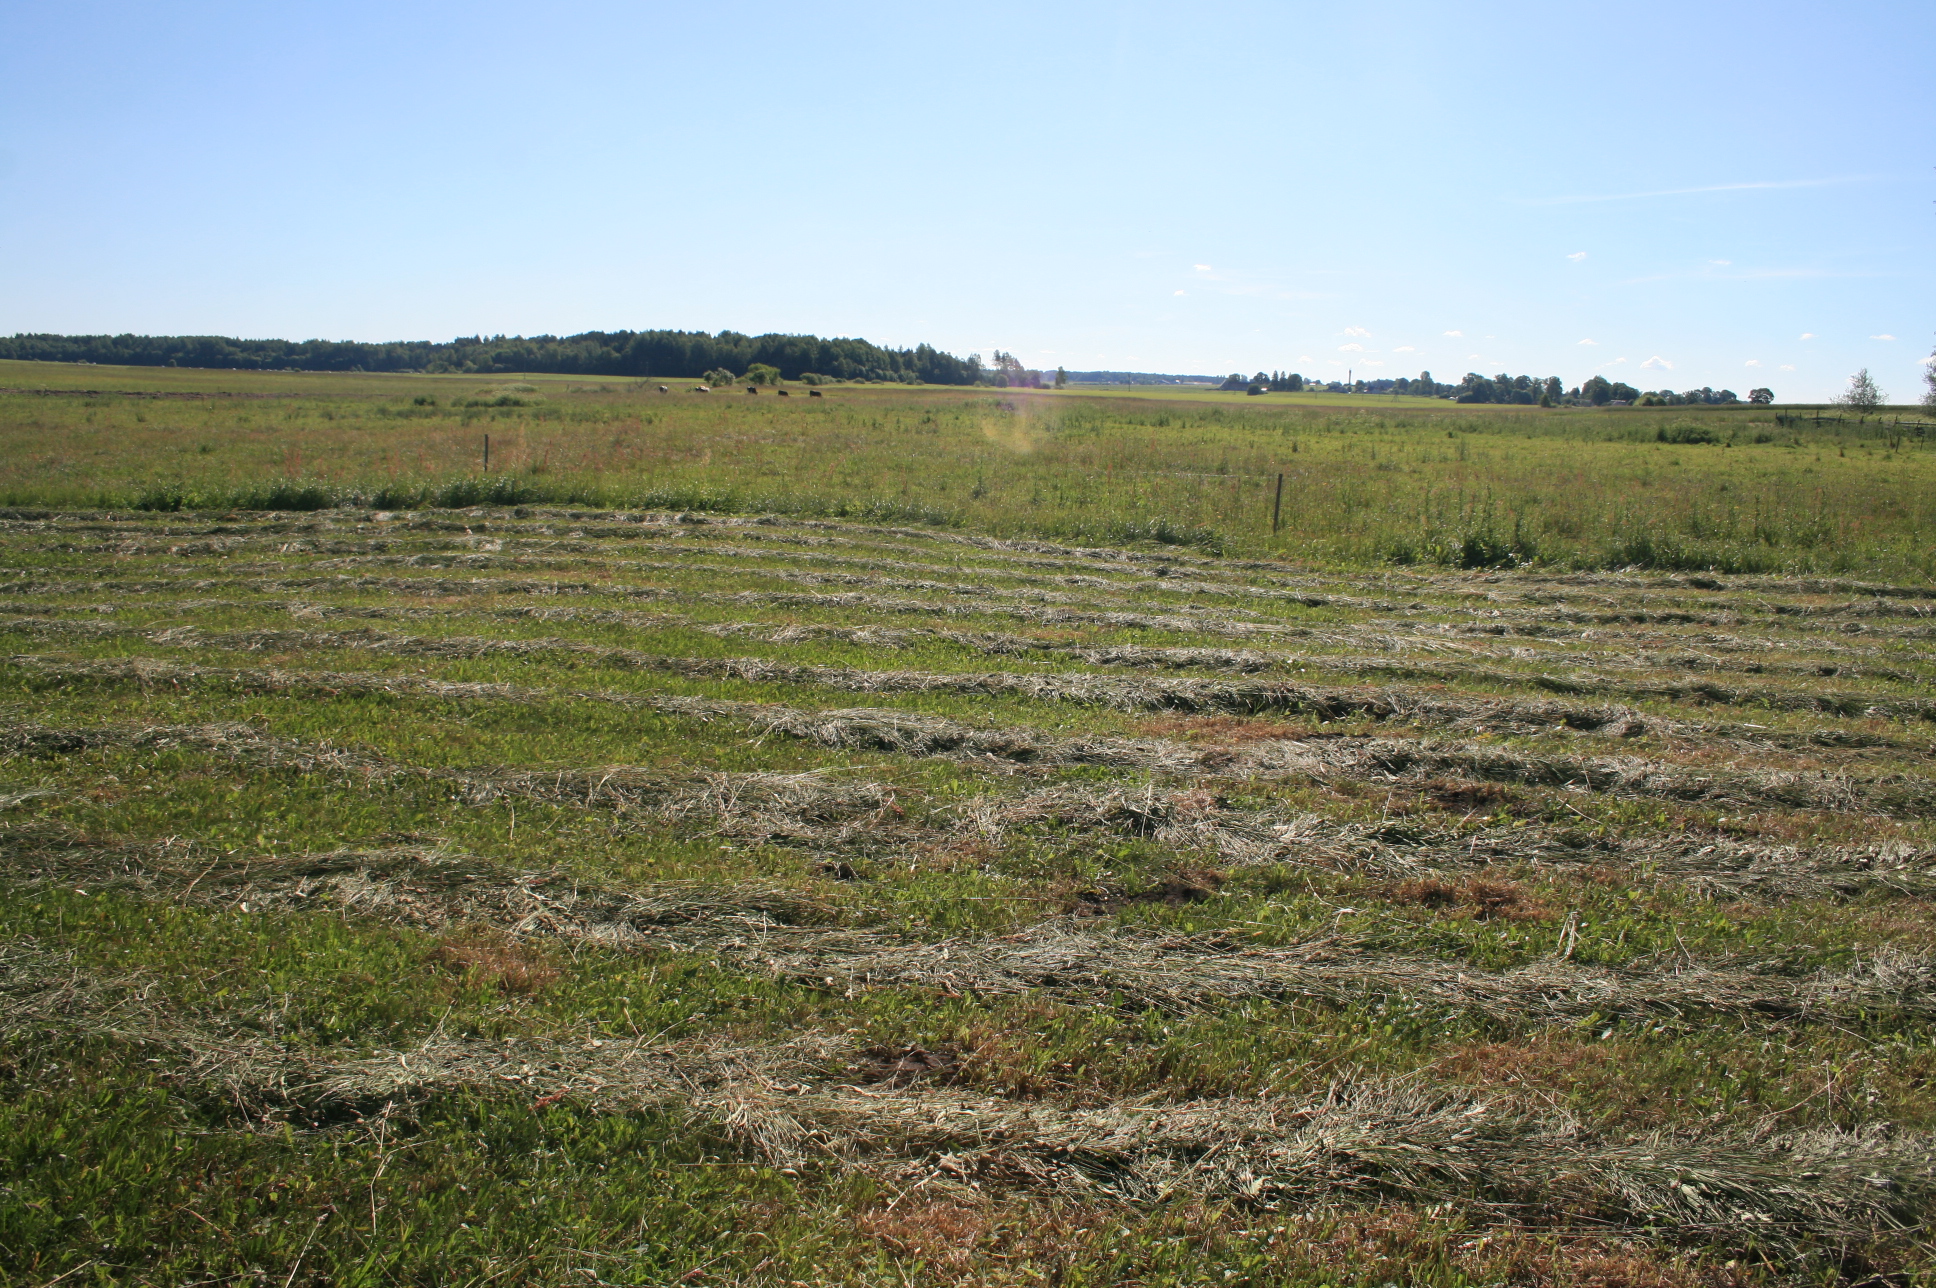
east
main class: Grassland
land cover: Grassland without tree/shrub cover
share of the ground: > 75 %
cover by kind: herbaceous plants 100 %
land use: Agriculture (excluding fallow land and kitchen gardens)
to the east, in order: Grassland without tree/shrub cover; Fences; Grassland without tree/shrub cover; Fences; Grassland without tree/shrub cover
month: June
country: LT
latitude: 55.4648
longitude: 22.1231
